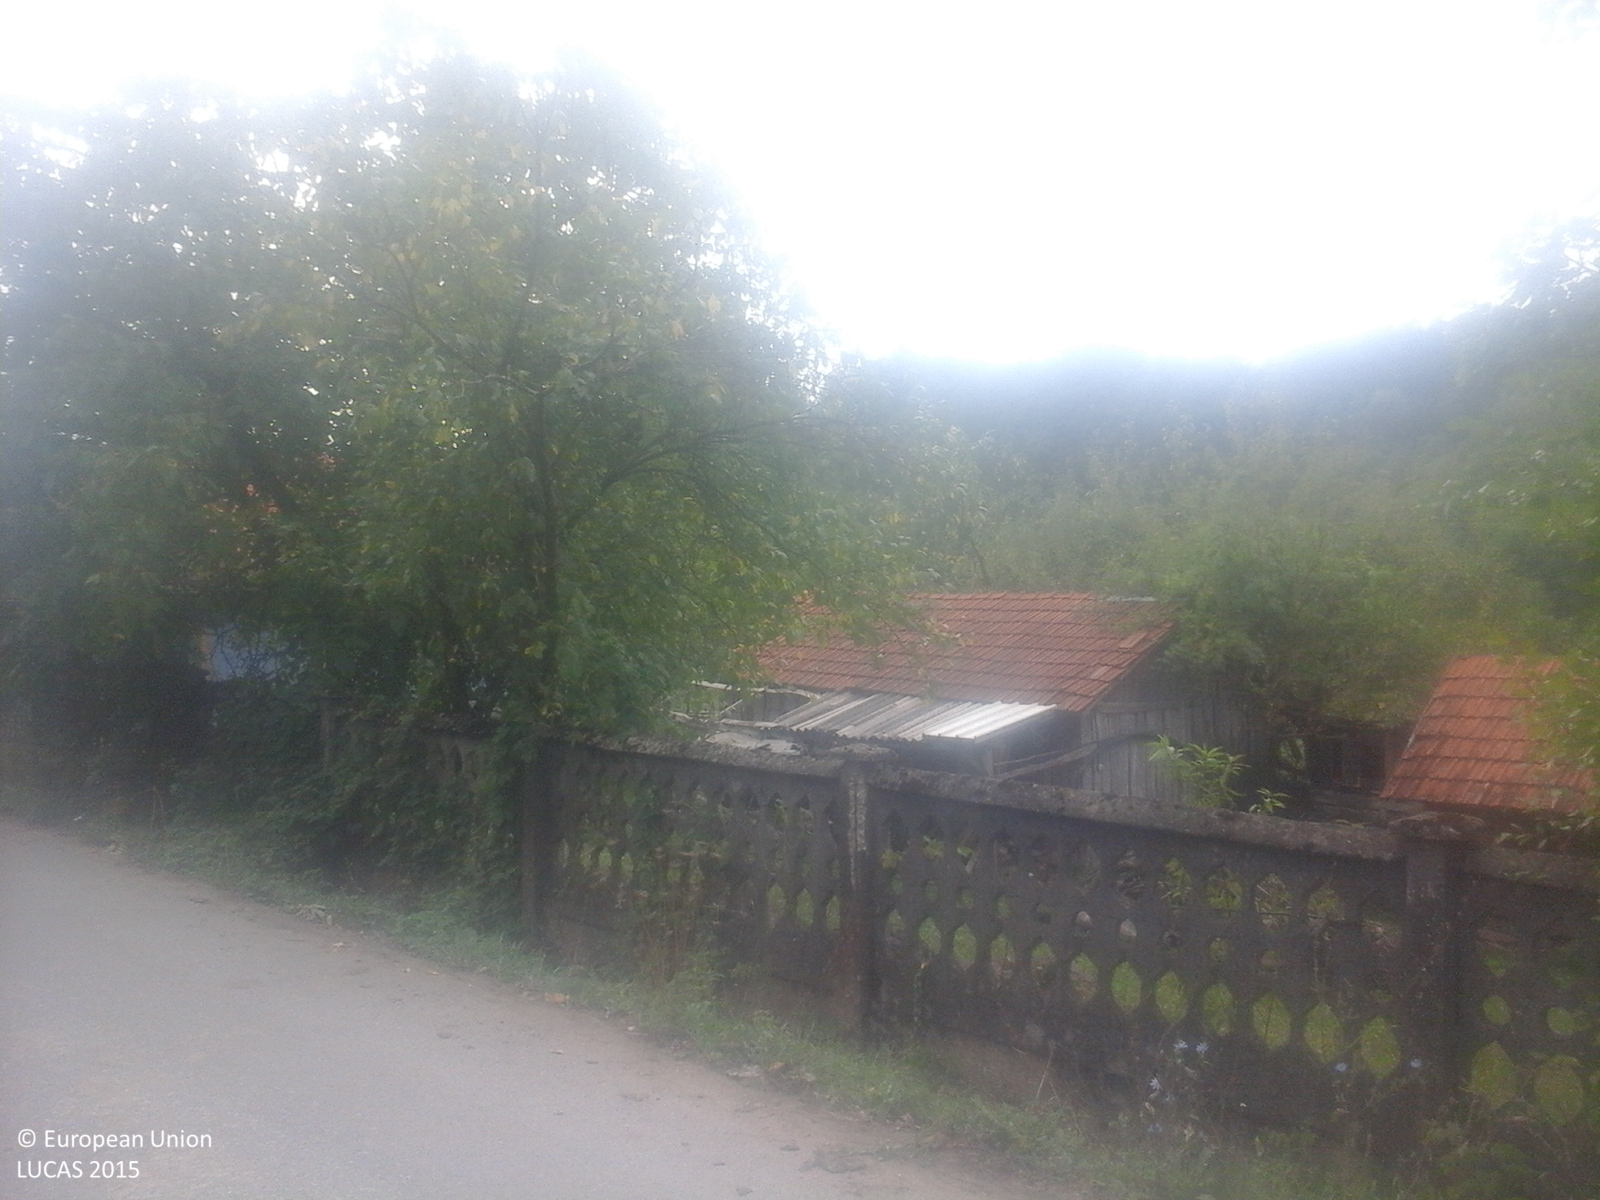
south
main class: Cropland
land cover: Other fruit trees and berries
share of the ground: 50 - 75 %
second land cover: Grassland without tree/shrub cover
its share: > 75 %
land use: Agriculture (excluding fallow land and kitchen gardens)
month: September
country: RO
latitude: 46.0565
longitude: 22.9161
